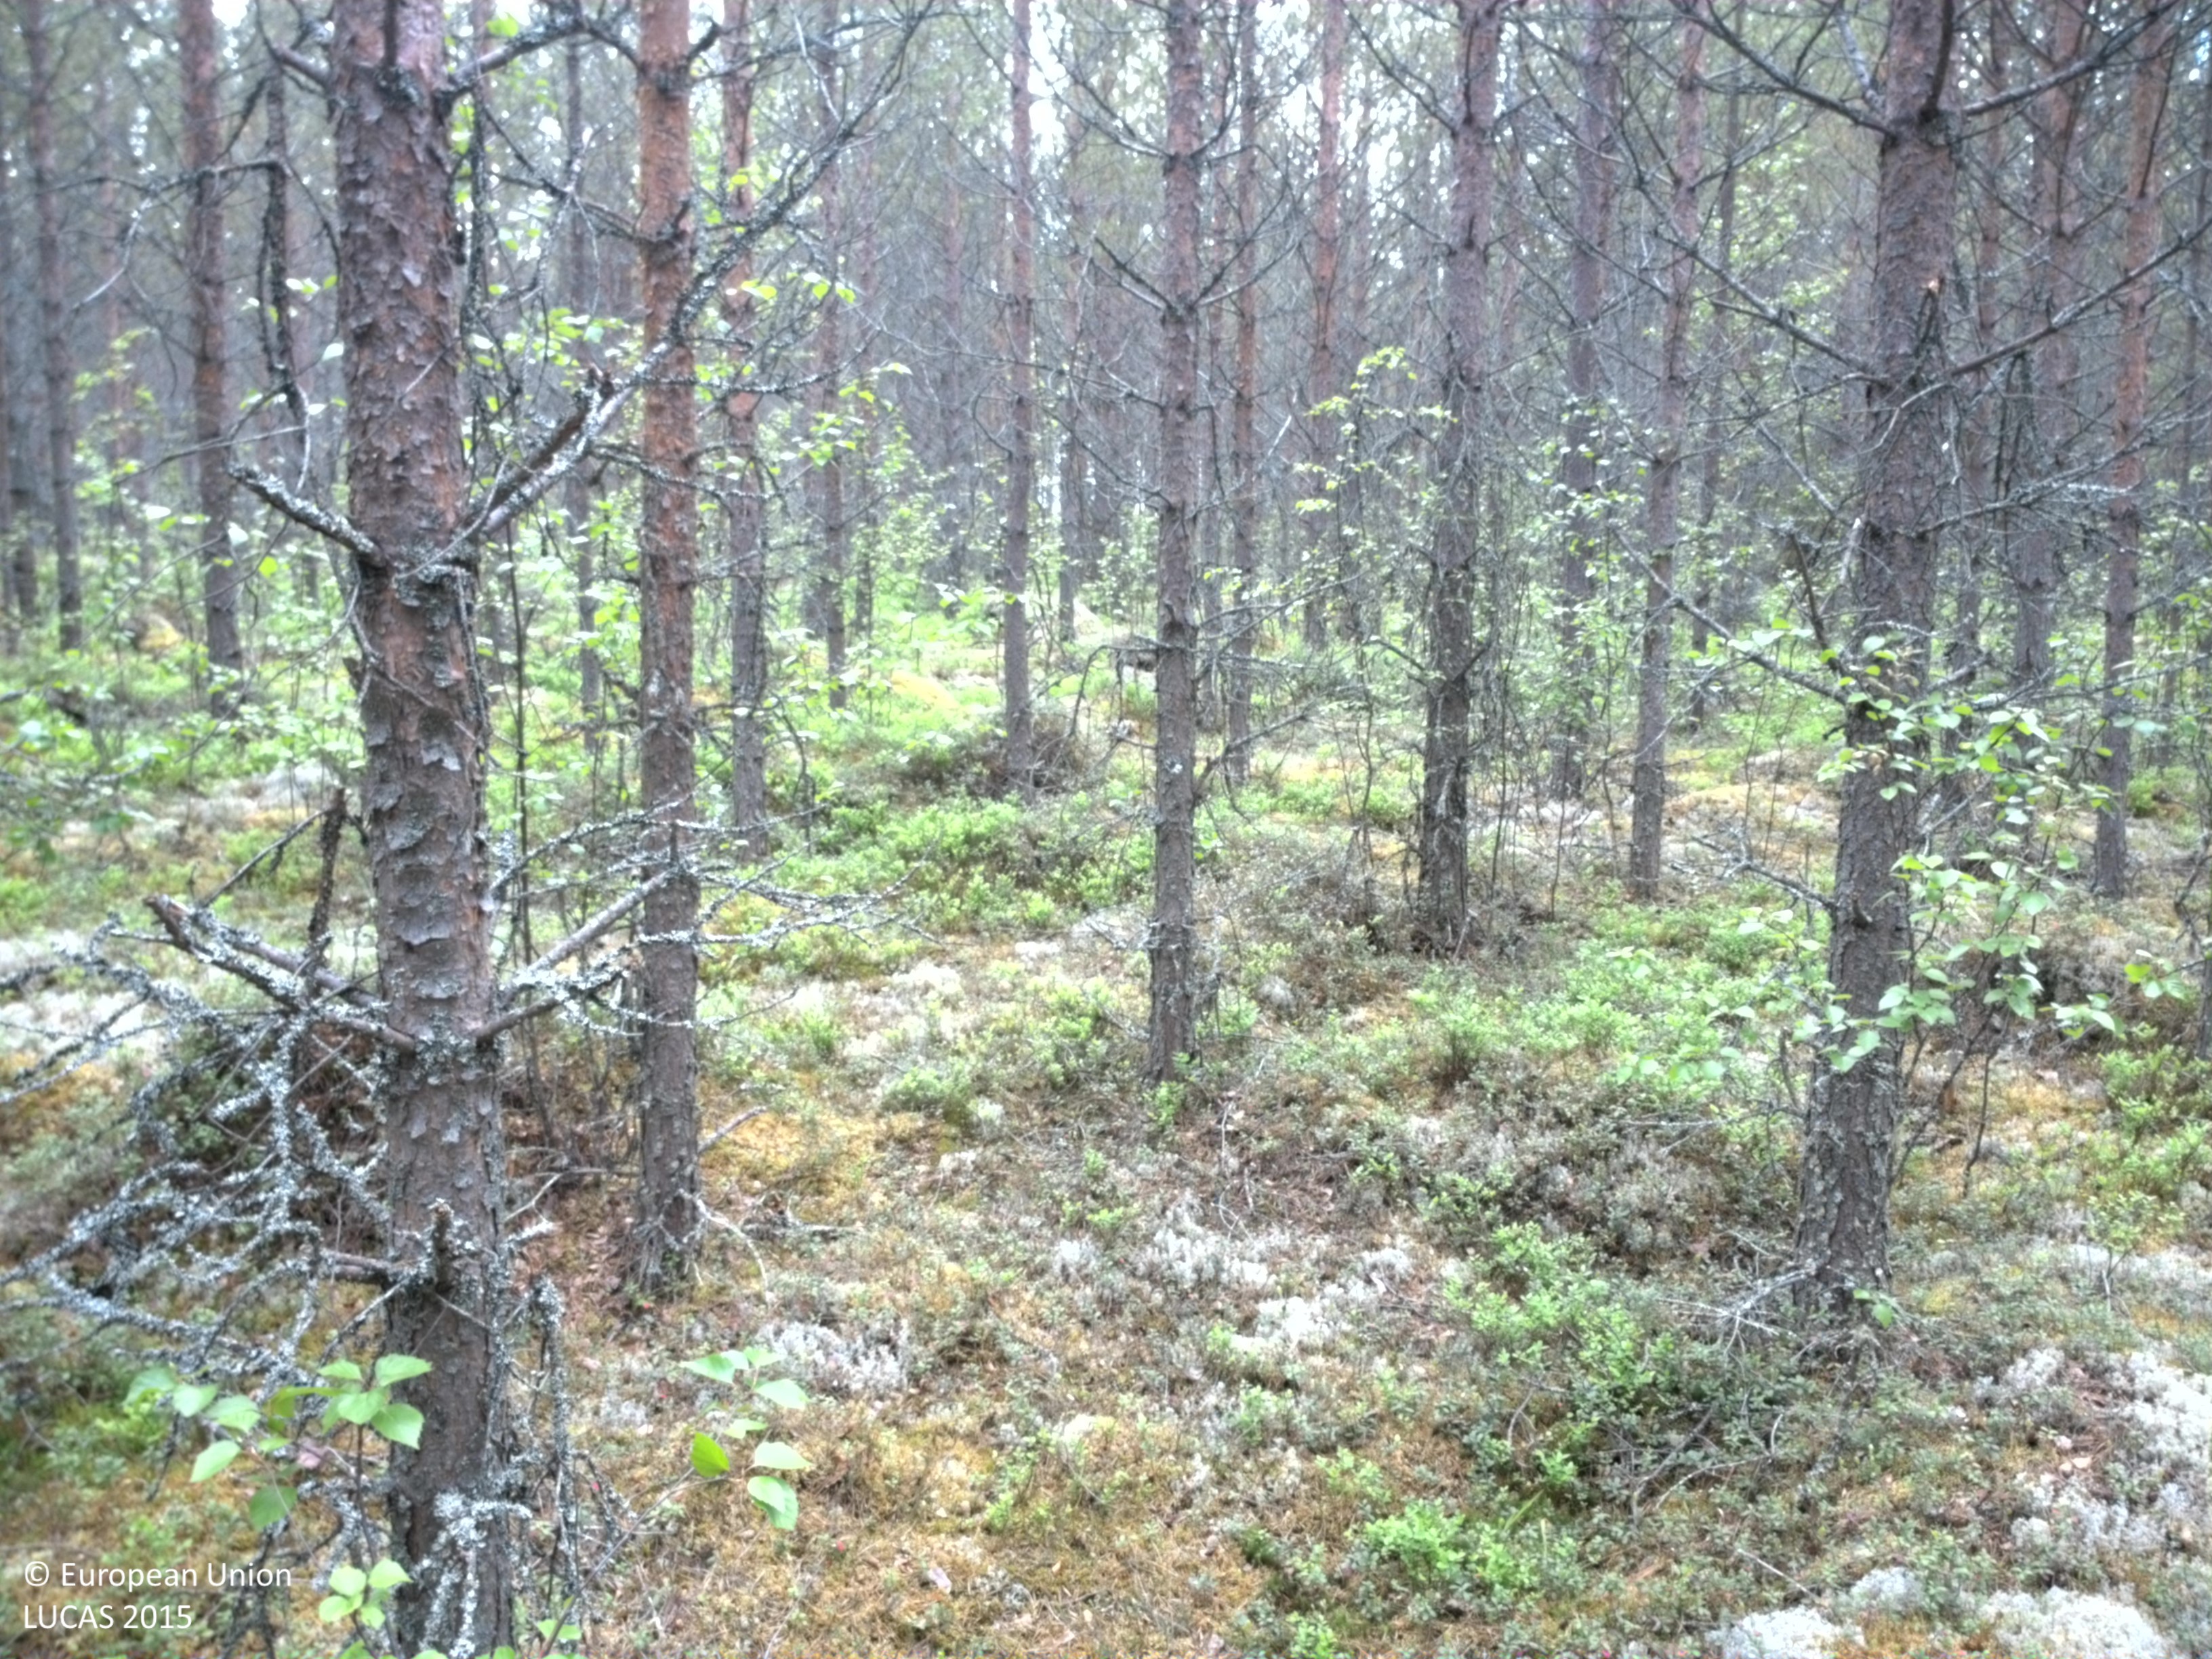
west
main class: Woodland
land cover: Pine dominated coniferous woodland
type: boreal forest
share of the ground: > 75 %
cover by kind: coniferous forest trees 80 %, lichens and mosses 20 %
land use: Forestry
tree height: < 5 m
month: June
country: SE
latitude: 61.2896
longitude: 13.5519
